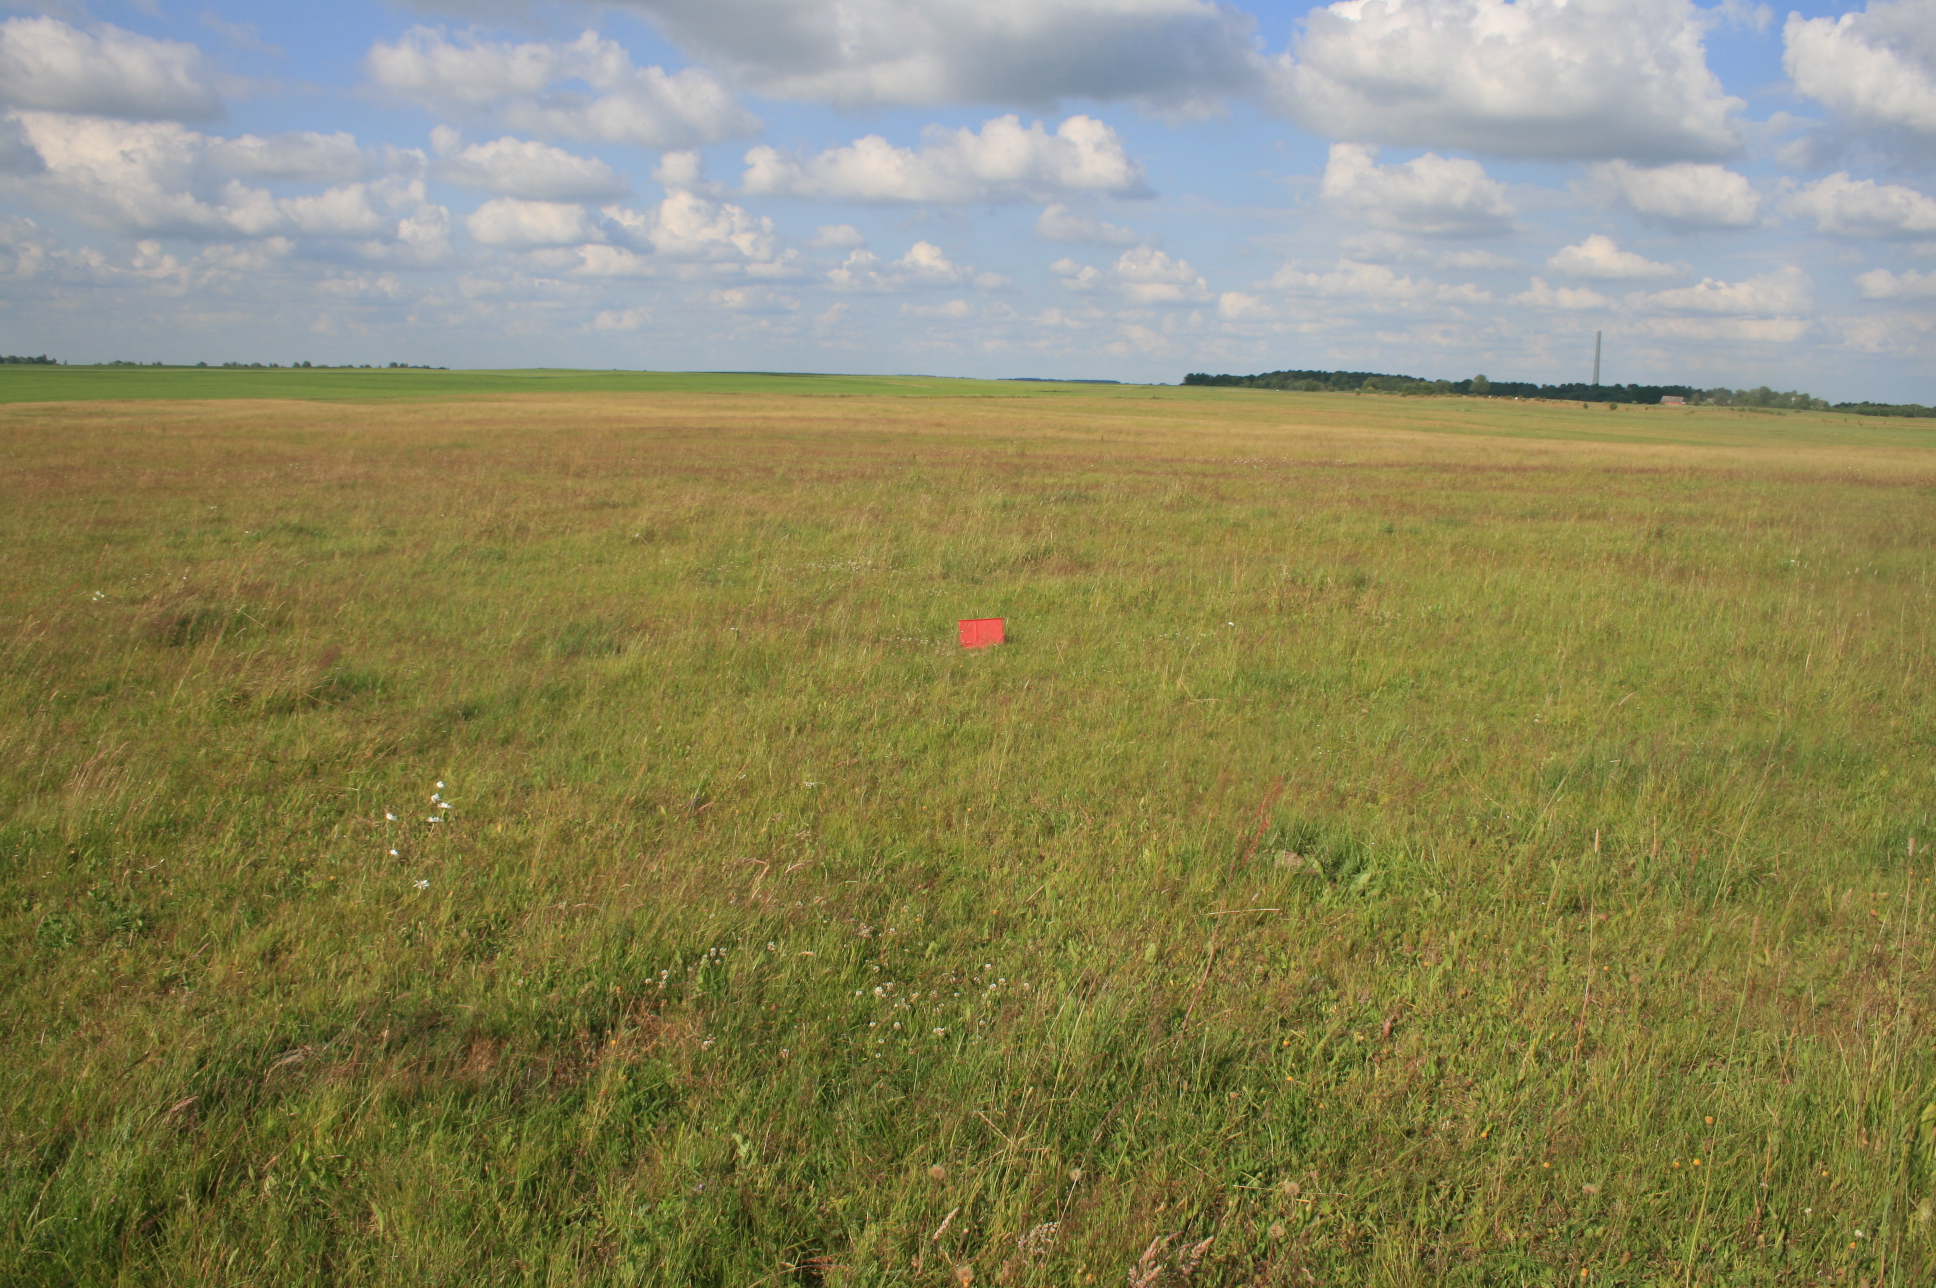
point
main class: Grassland
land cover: Grassland without tree/shrub cover
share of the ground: > 75 %
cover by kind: herbaceous plants 100 %
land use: Agriculture (excluding fallow land and kitchen gardens)
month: June
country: LT
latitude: 55.2056
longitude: 21.9802
